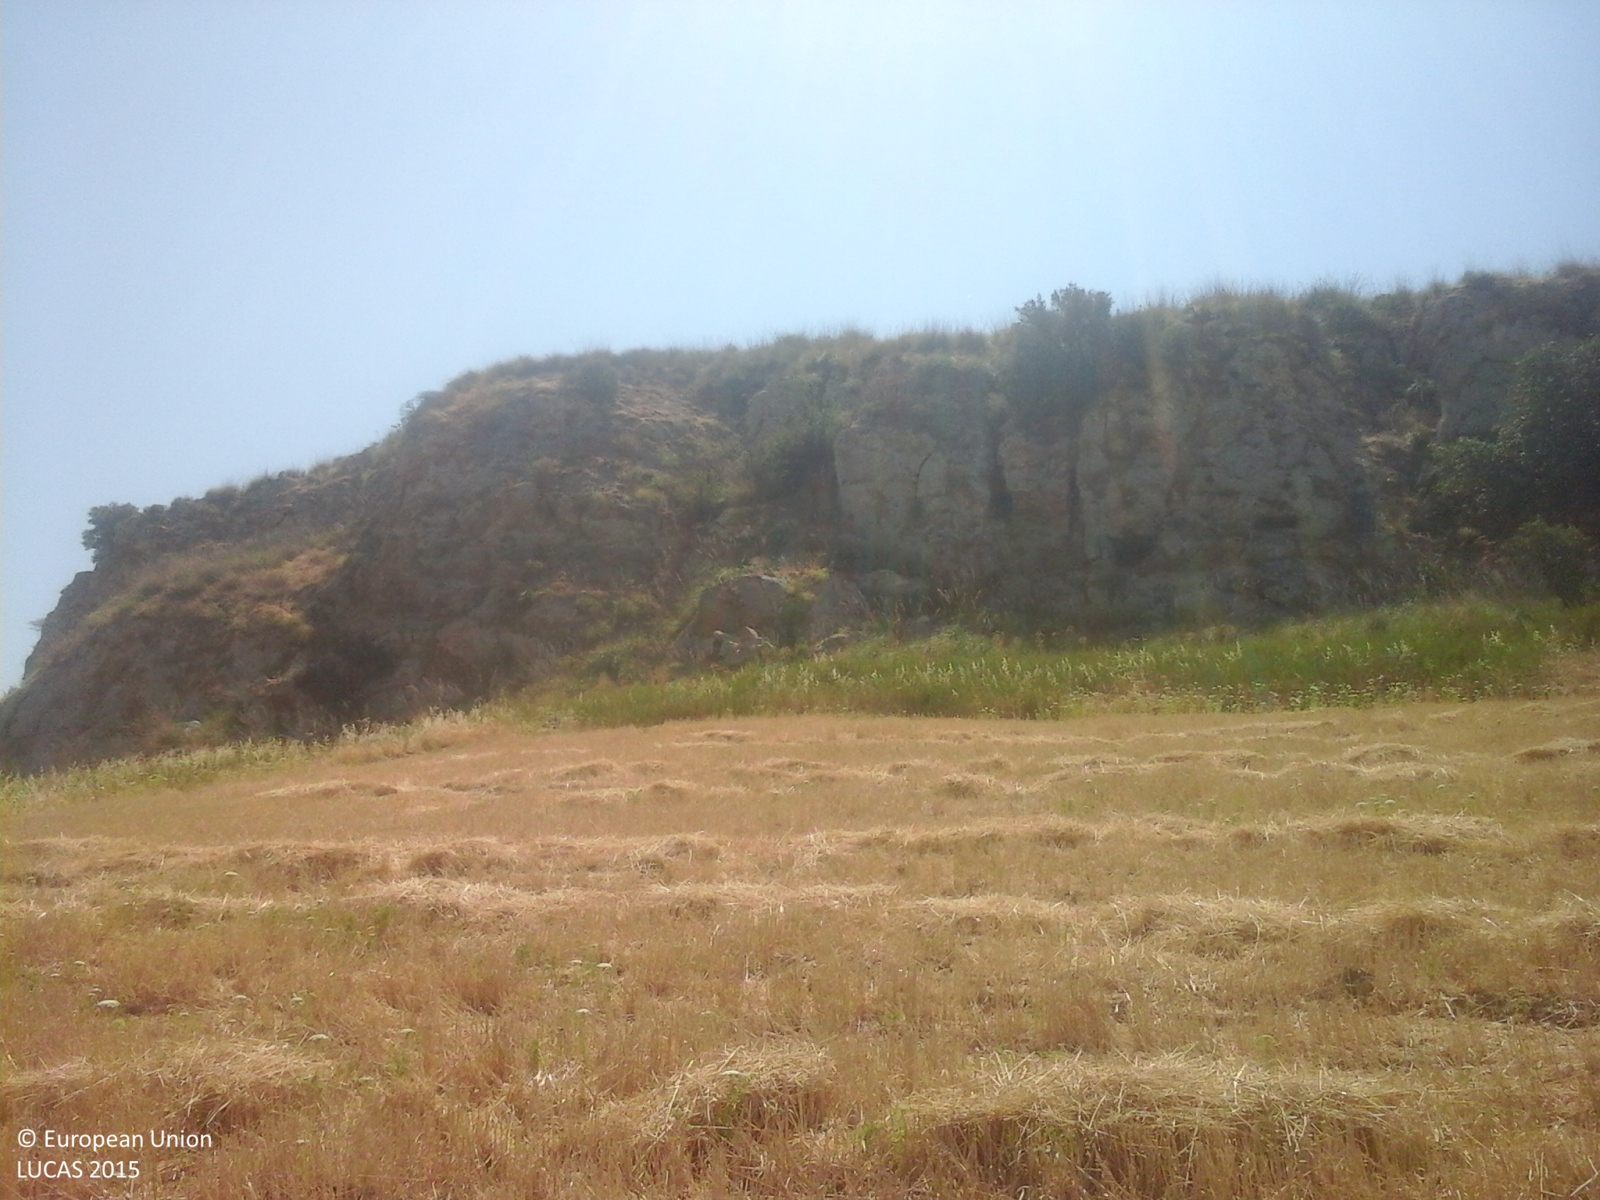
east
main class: Cropland
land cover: Durum wheat
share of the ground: > 75 %
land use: Agriculture (excluding fallow land and kitchen gardens)
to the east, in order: Durum wheat; Grassland without tree/shrub cover; Rocks and stones; Shrubland without tree cover; Grassland without tree/shrub cover
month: July
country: IT
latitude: 37.4646
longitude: 13.5120
